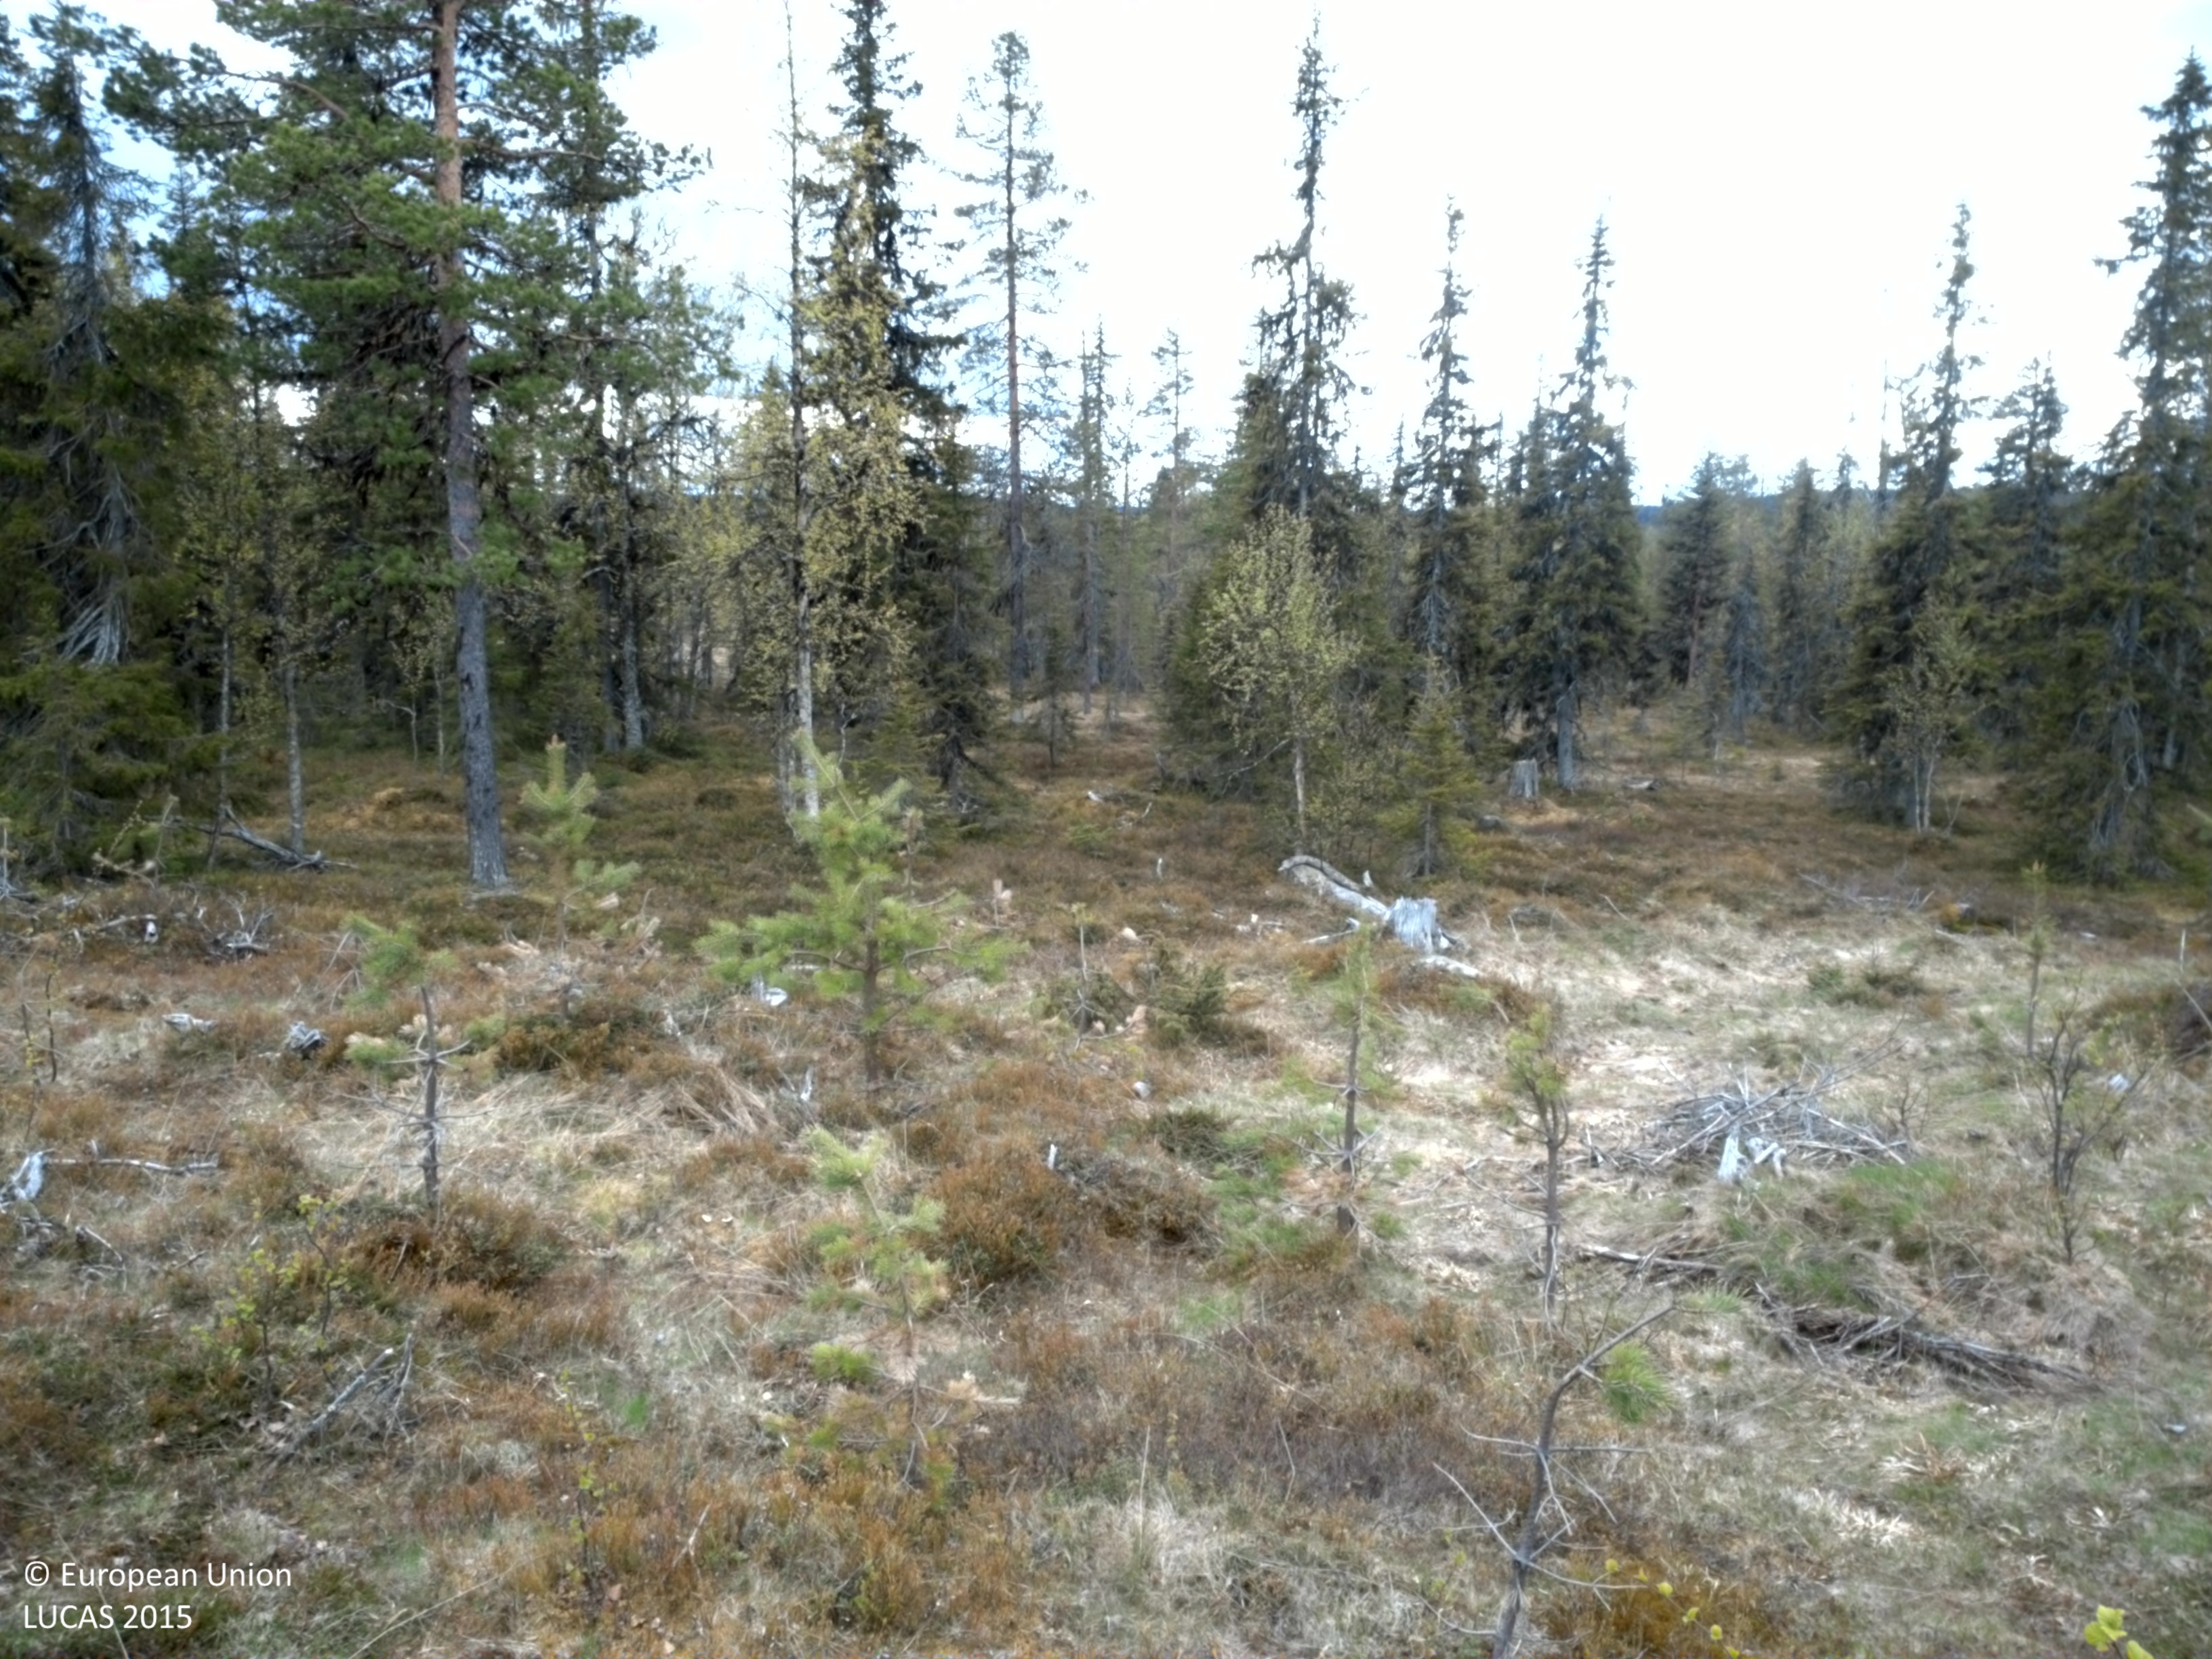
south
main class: Shrubland
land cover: Shrubland with sparse tree cover
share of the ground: > 75 %
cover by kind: shrubs 85 %, herbaceous plants 10 %, coniferous forest trees 5 %
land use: Forestry
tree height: < 5 m
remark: Clear cut
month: June
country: SE
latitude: 66.0399
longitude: 18.5839
